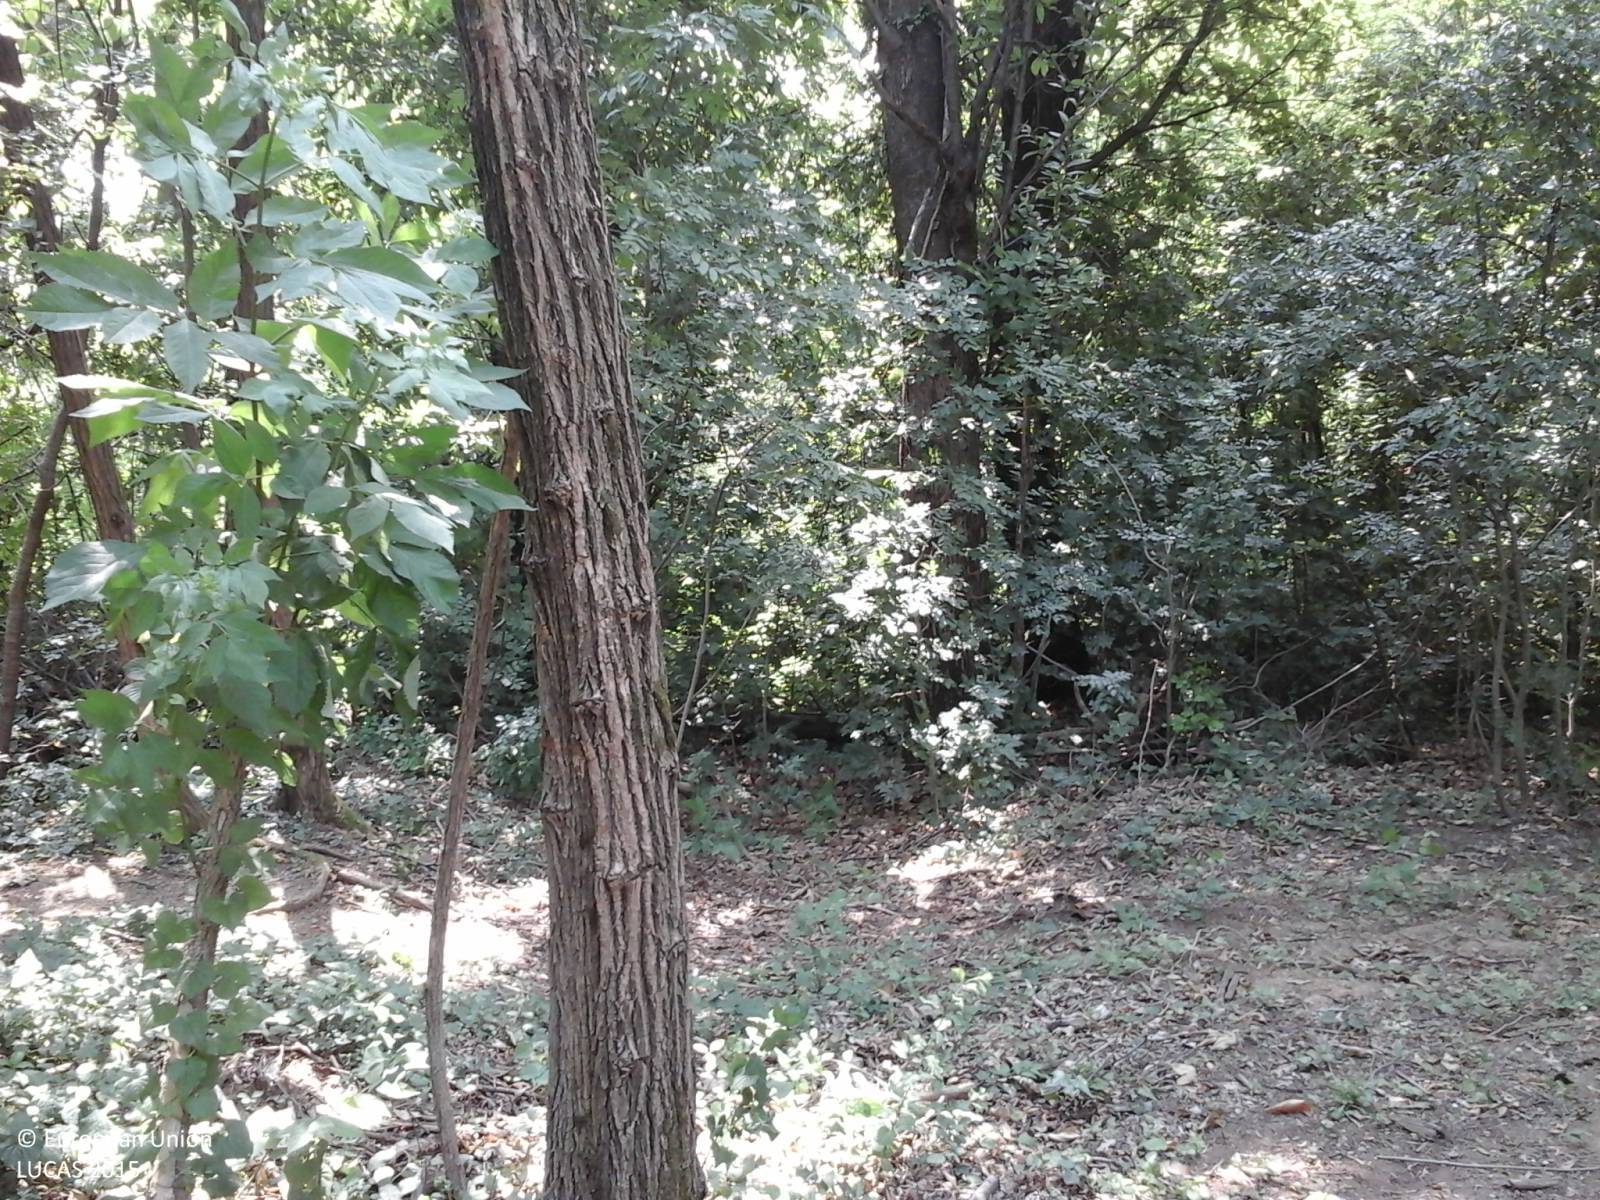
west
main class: Woodland
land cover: Broadleaved woodland
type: thermophilous deciduous forest
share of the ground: > 75 %
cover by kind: broadleaved forest trees 90 %, shrubs 10 %
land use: Forestry
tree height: > 5 m
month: June
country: IT
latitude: 46.1968
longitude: 13.1455
